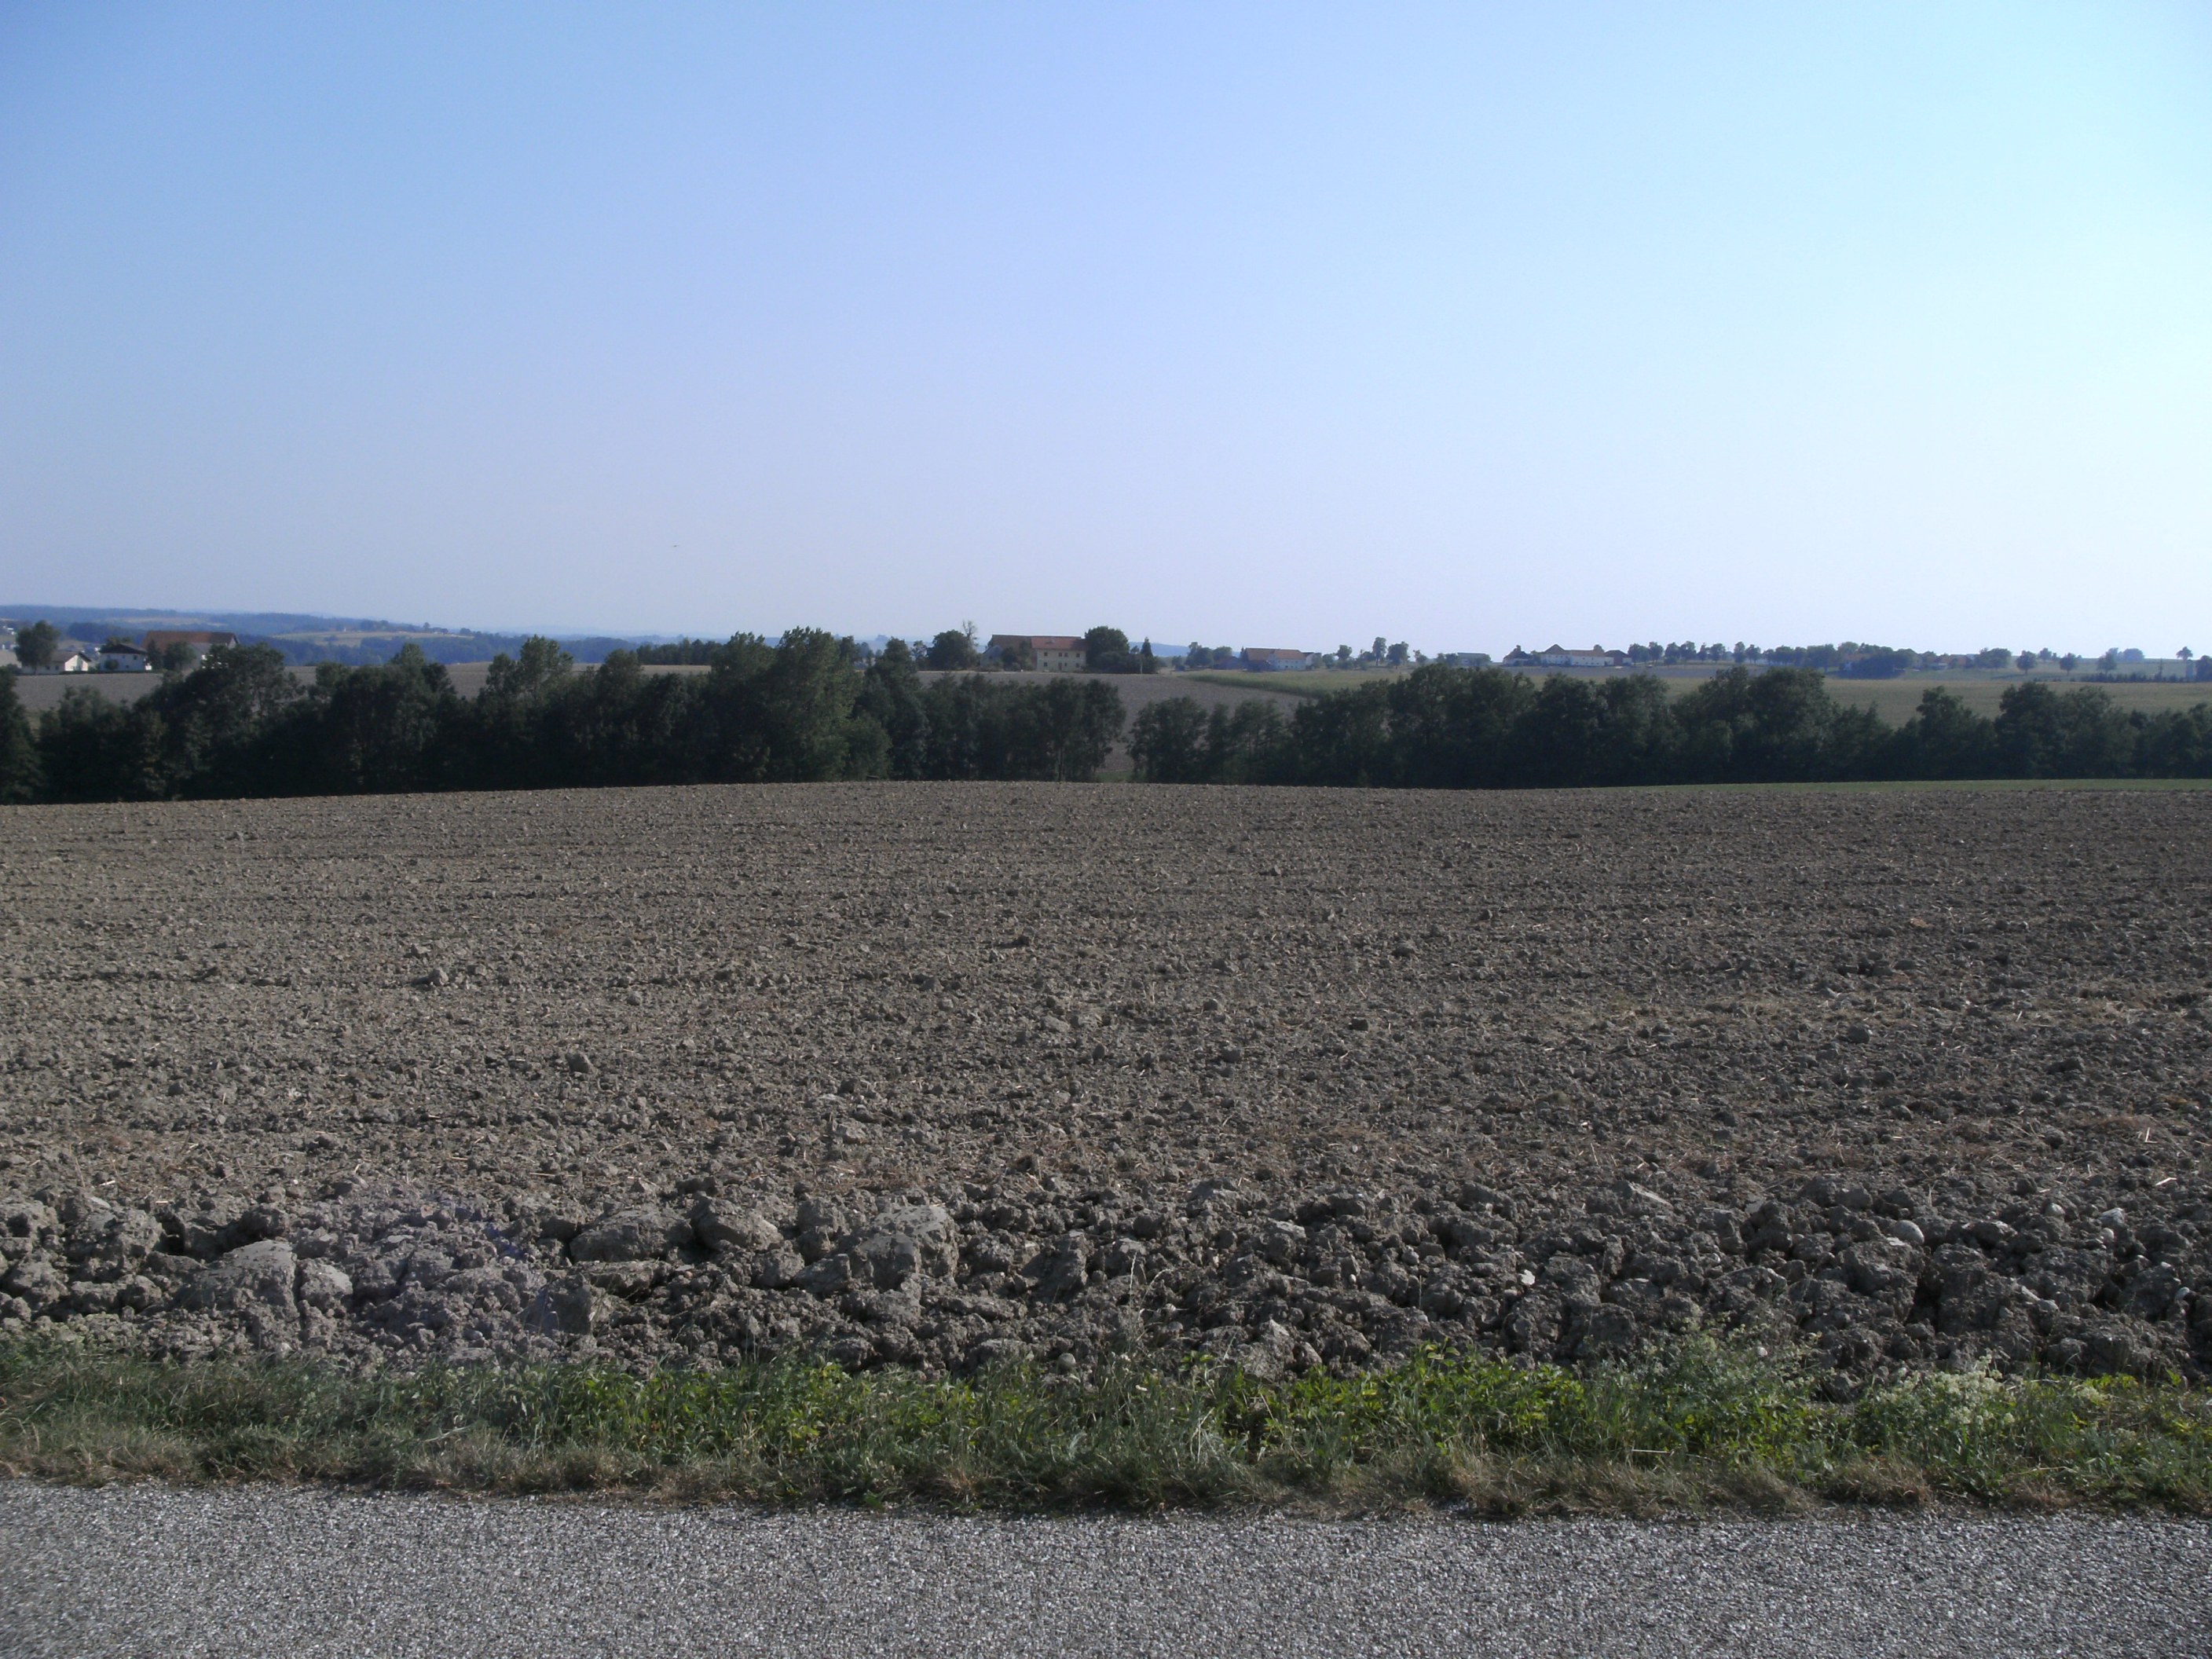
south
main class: Cropland
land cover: Other fresh vegetables
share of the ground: > 75 %
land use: Agriculture (excluding fallow land and kitchen gardens)
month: August
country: AT
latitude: 48.3475
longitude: 13.5212
